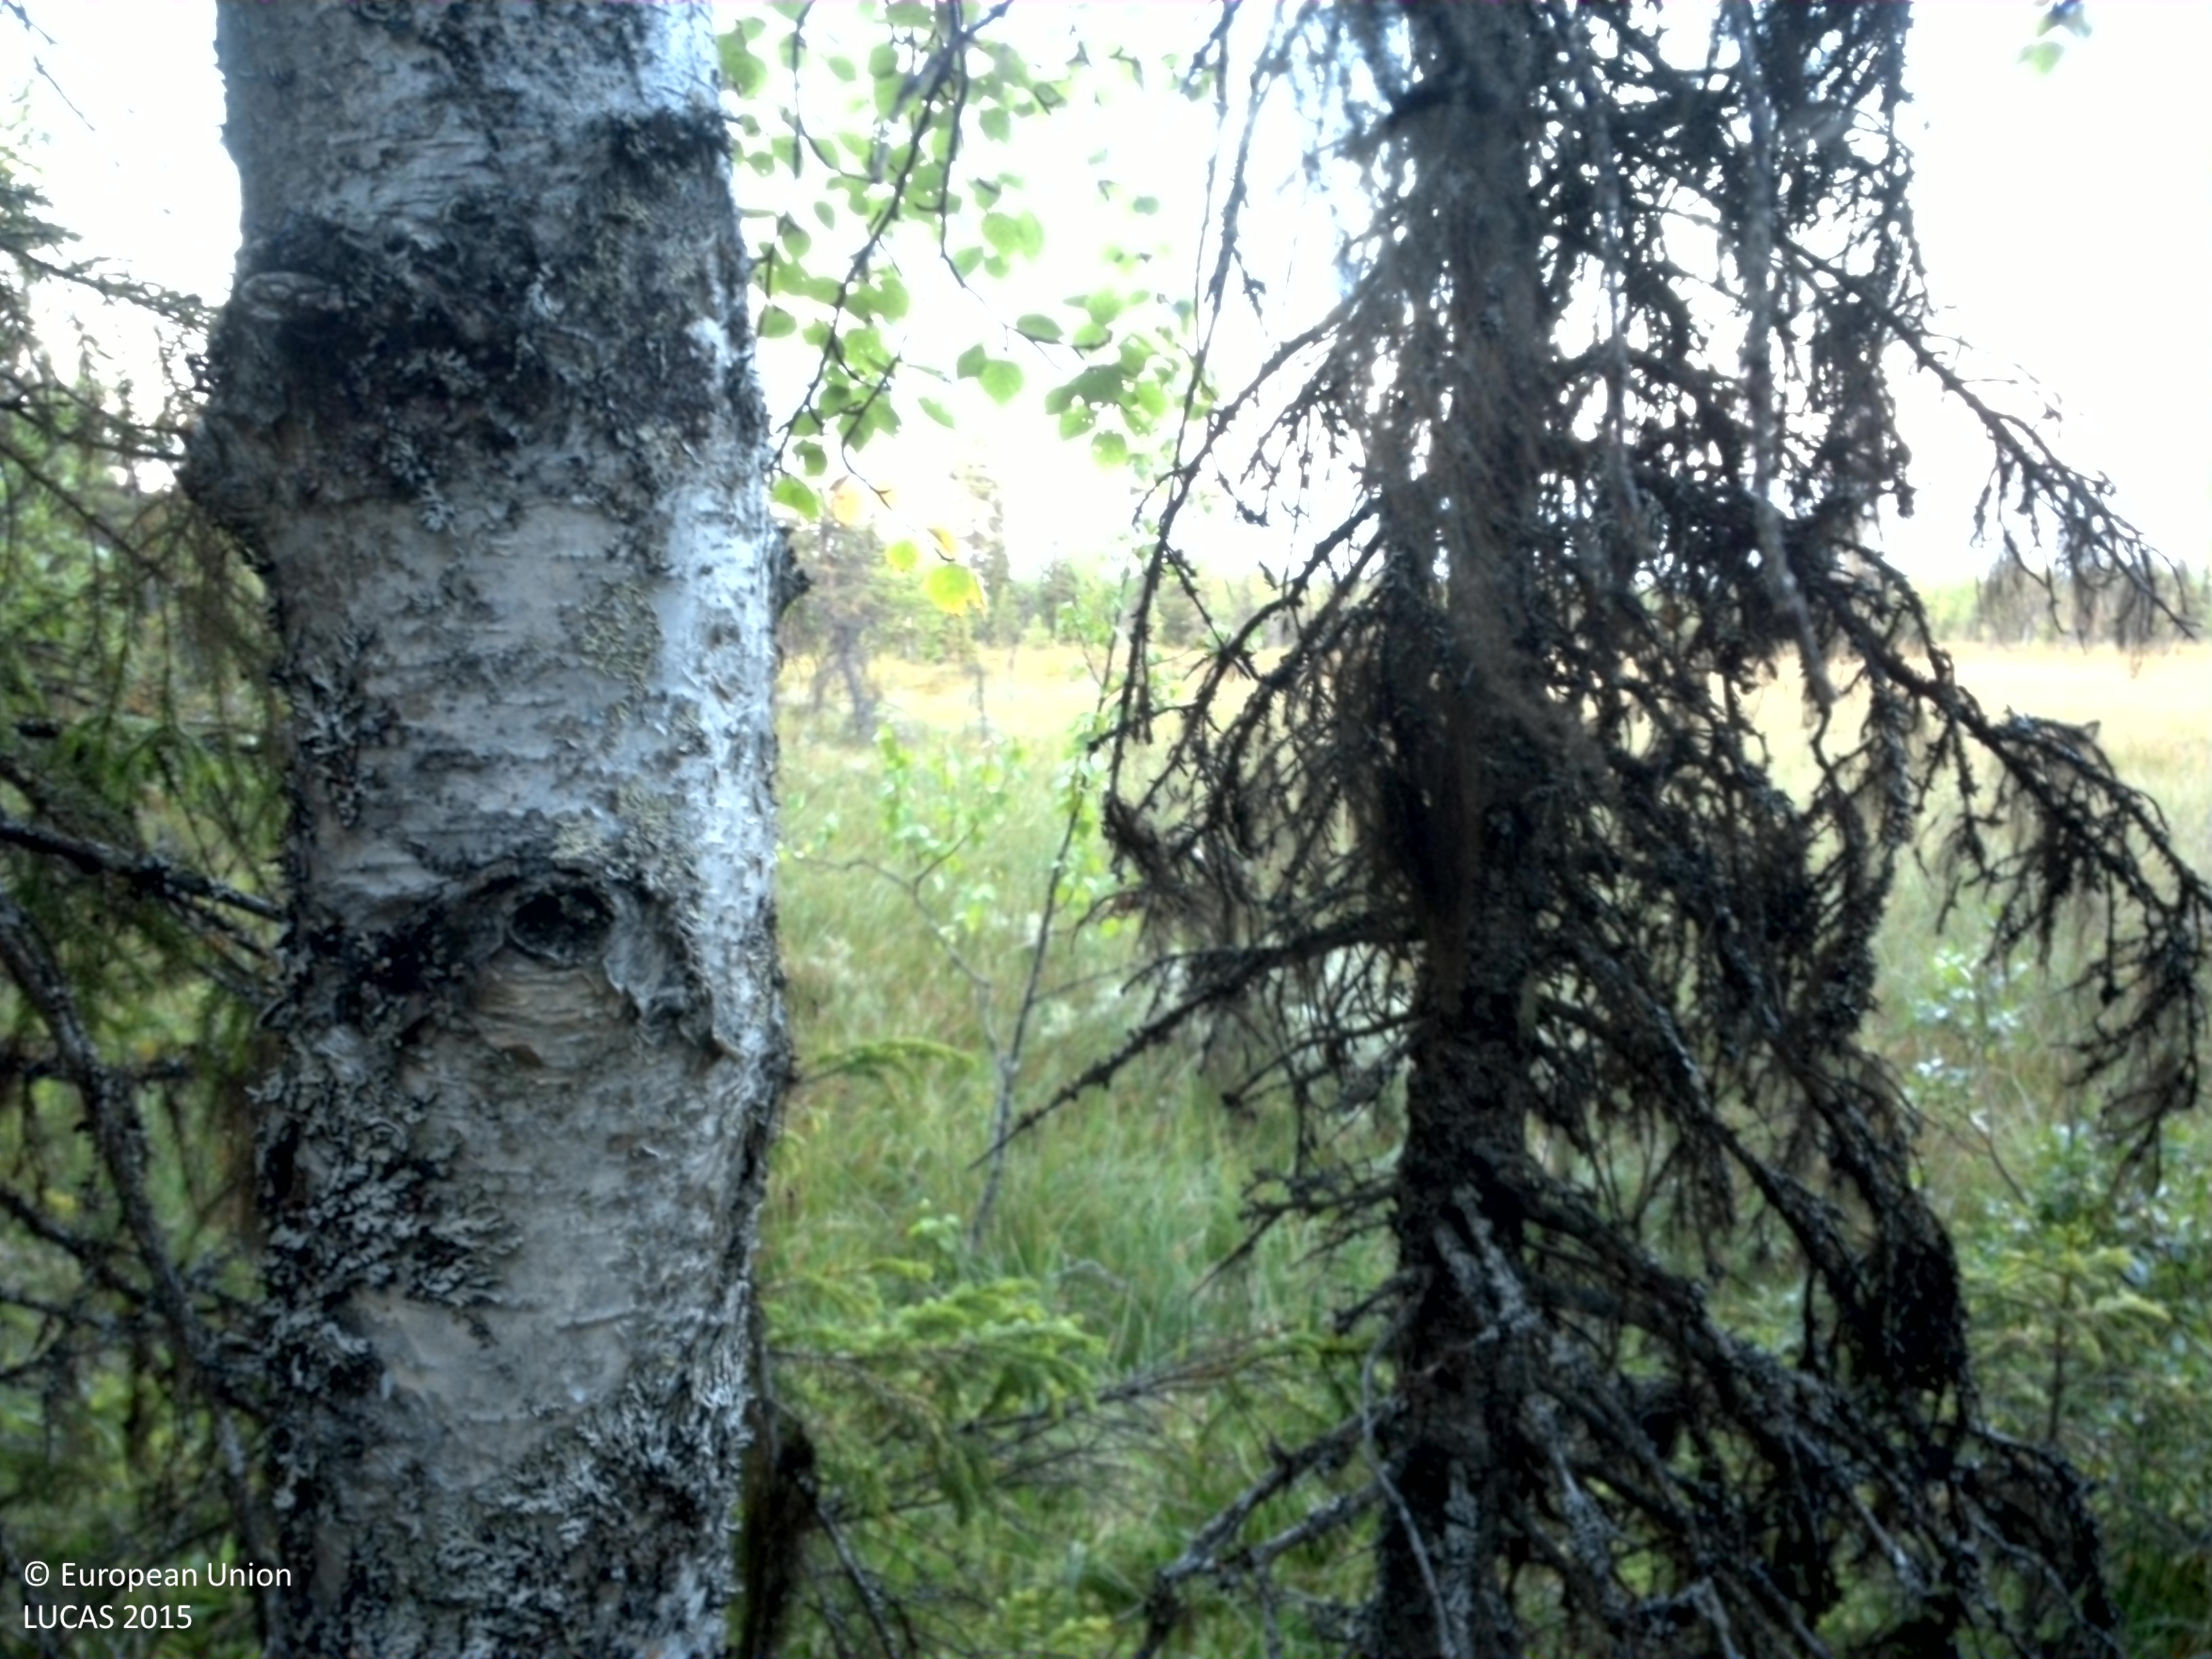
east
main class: Woodland
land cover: Spruce dominated mixed woodland
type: boreal forest
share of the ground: 25 - 50 %
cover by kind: shrubs 45 %, coniferous forest trees 20 %, lichens and mosses 20 %, broadleaved forest trees 10 %, herbaceous plants 5 %
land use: Forestry
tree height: > 5 m
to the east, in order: Spruce dominated mixed woodland; Peatbogs; Spruce dominated mixed woodland; Broadleaved woodland; Spruce dominated mixed woodland
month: August
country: SE
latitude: 64.7980
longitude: 16.7641
